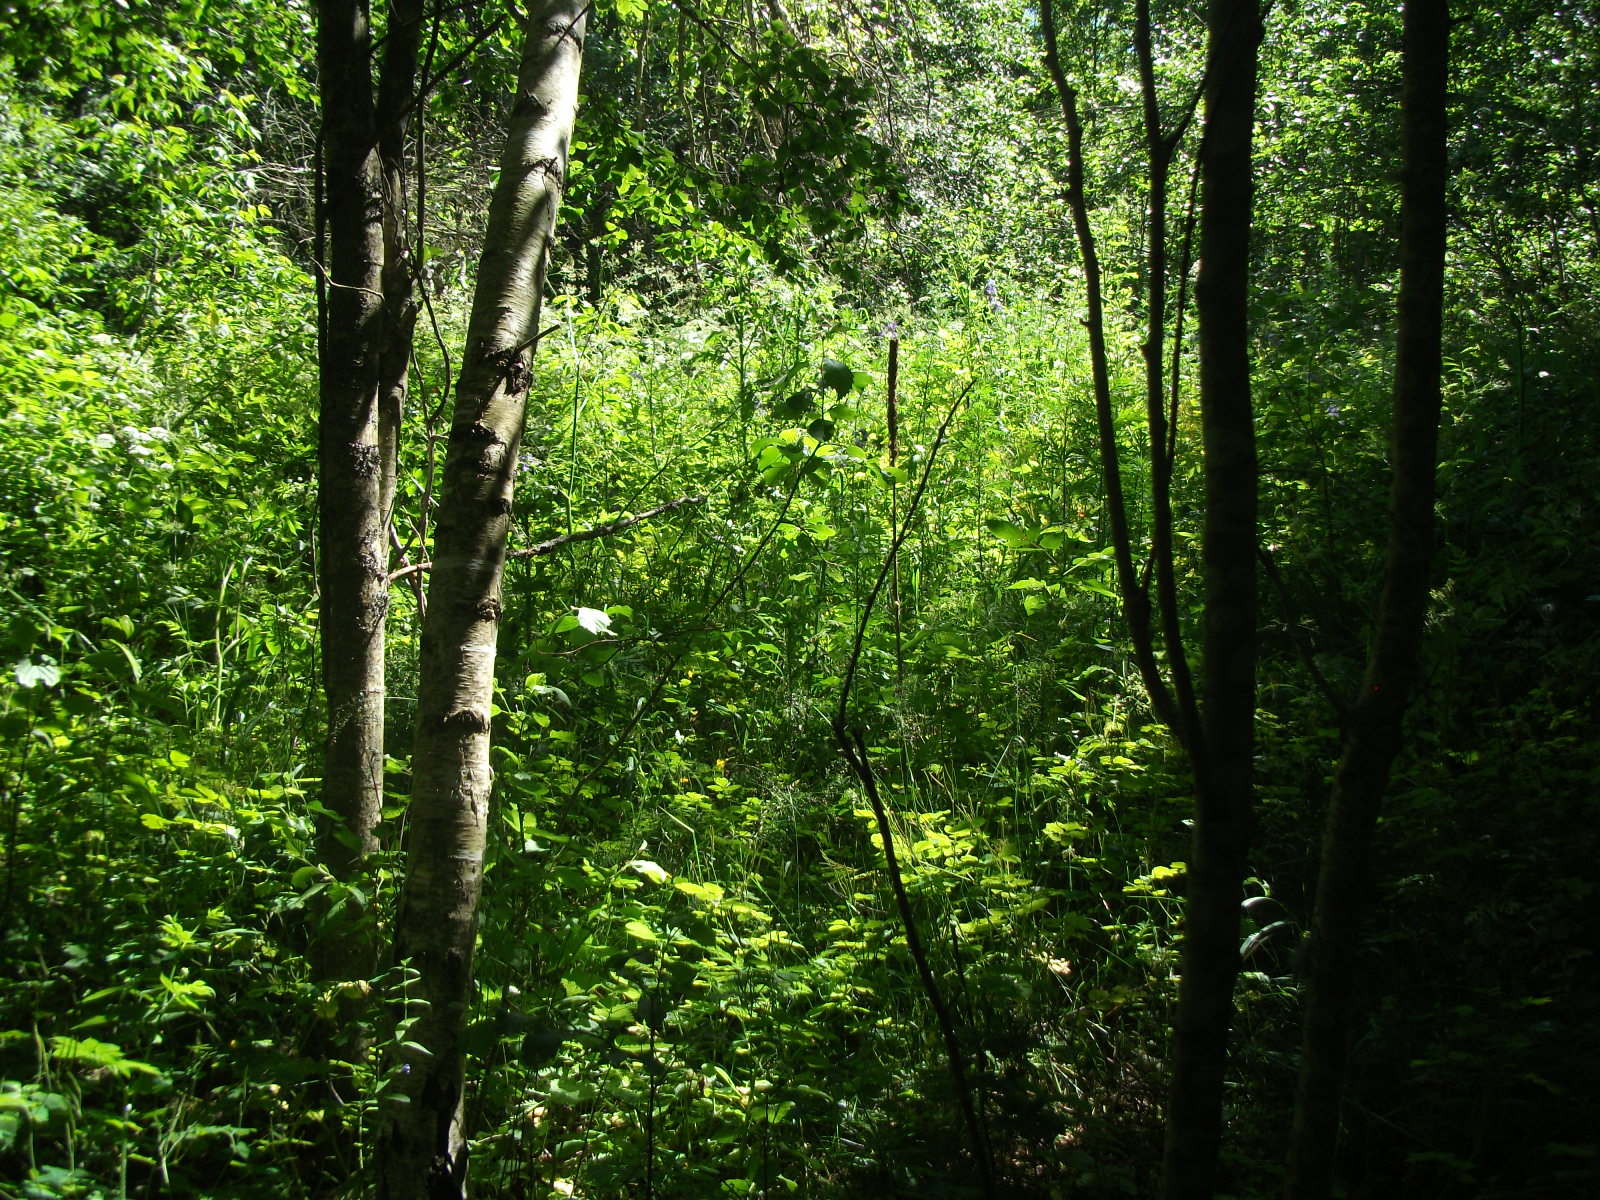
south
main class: Woodland
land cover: Broadleaved woodland
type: non-riverine alder, birch or aspen forest
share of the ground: > 75 %
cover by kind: broadleaved forest trees 100 %
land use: Forestry
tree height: > 5 m
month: July
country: LV
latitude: 56.7330
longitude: 26.1725
